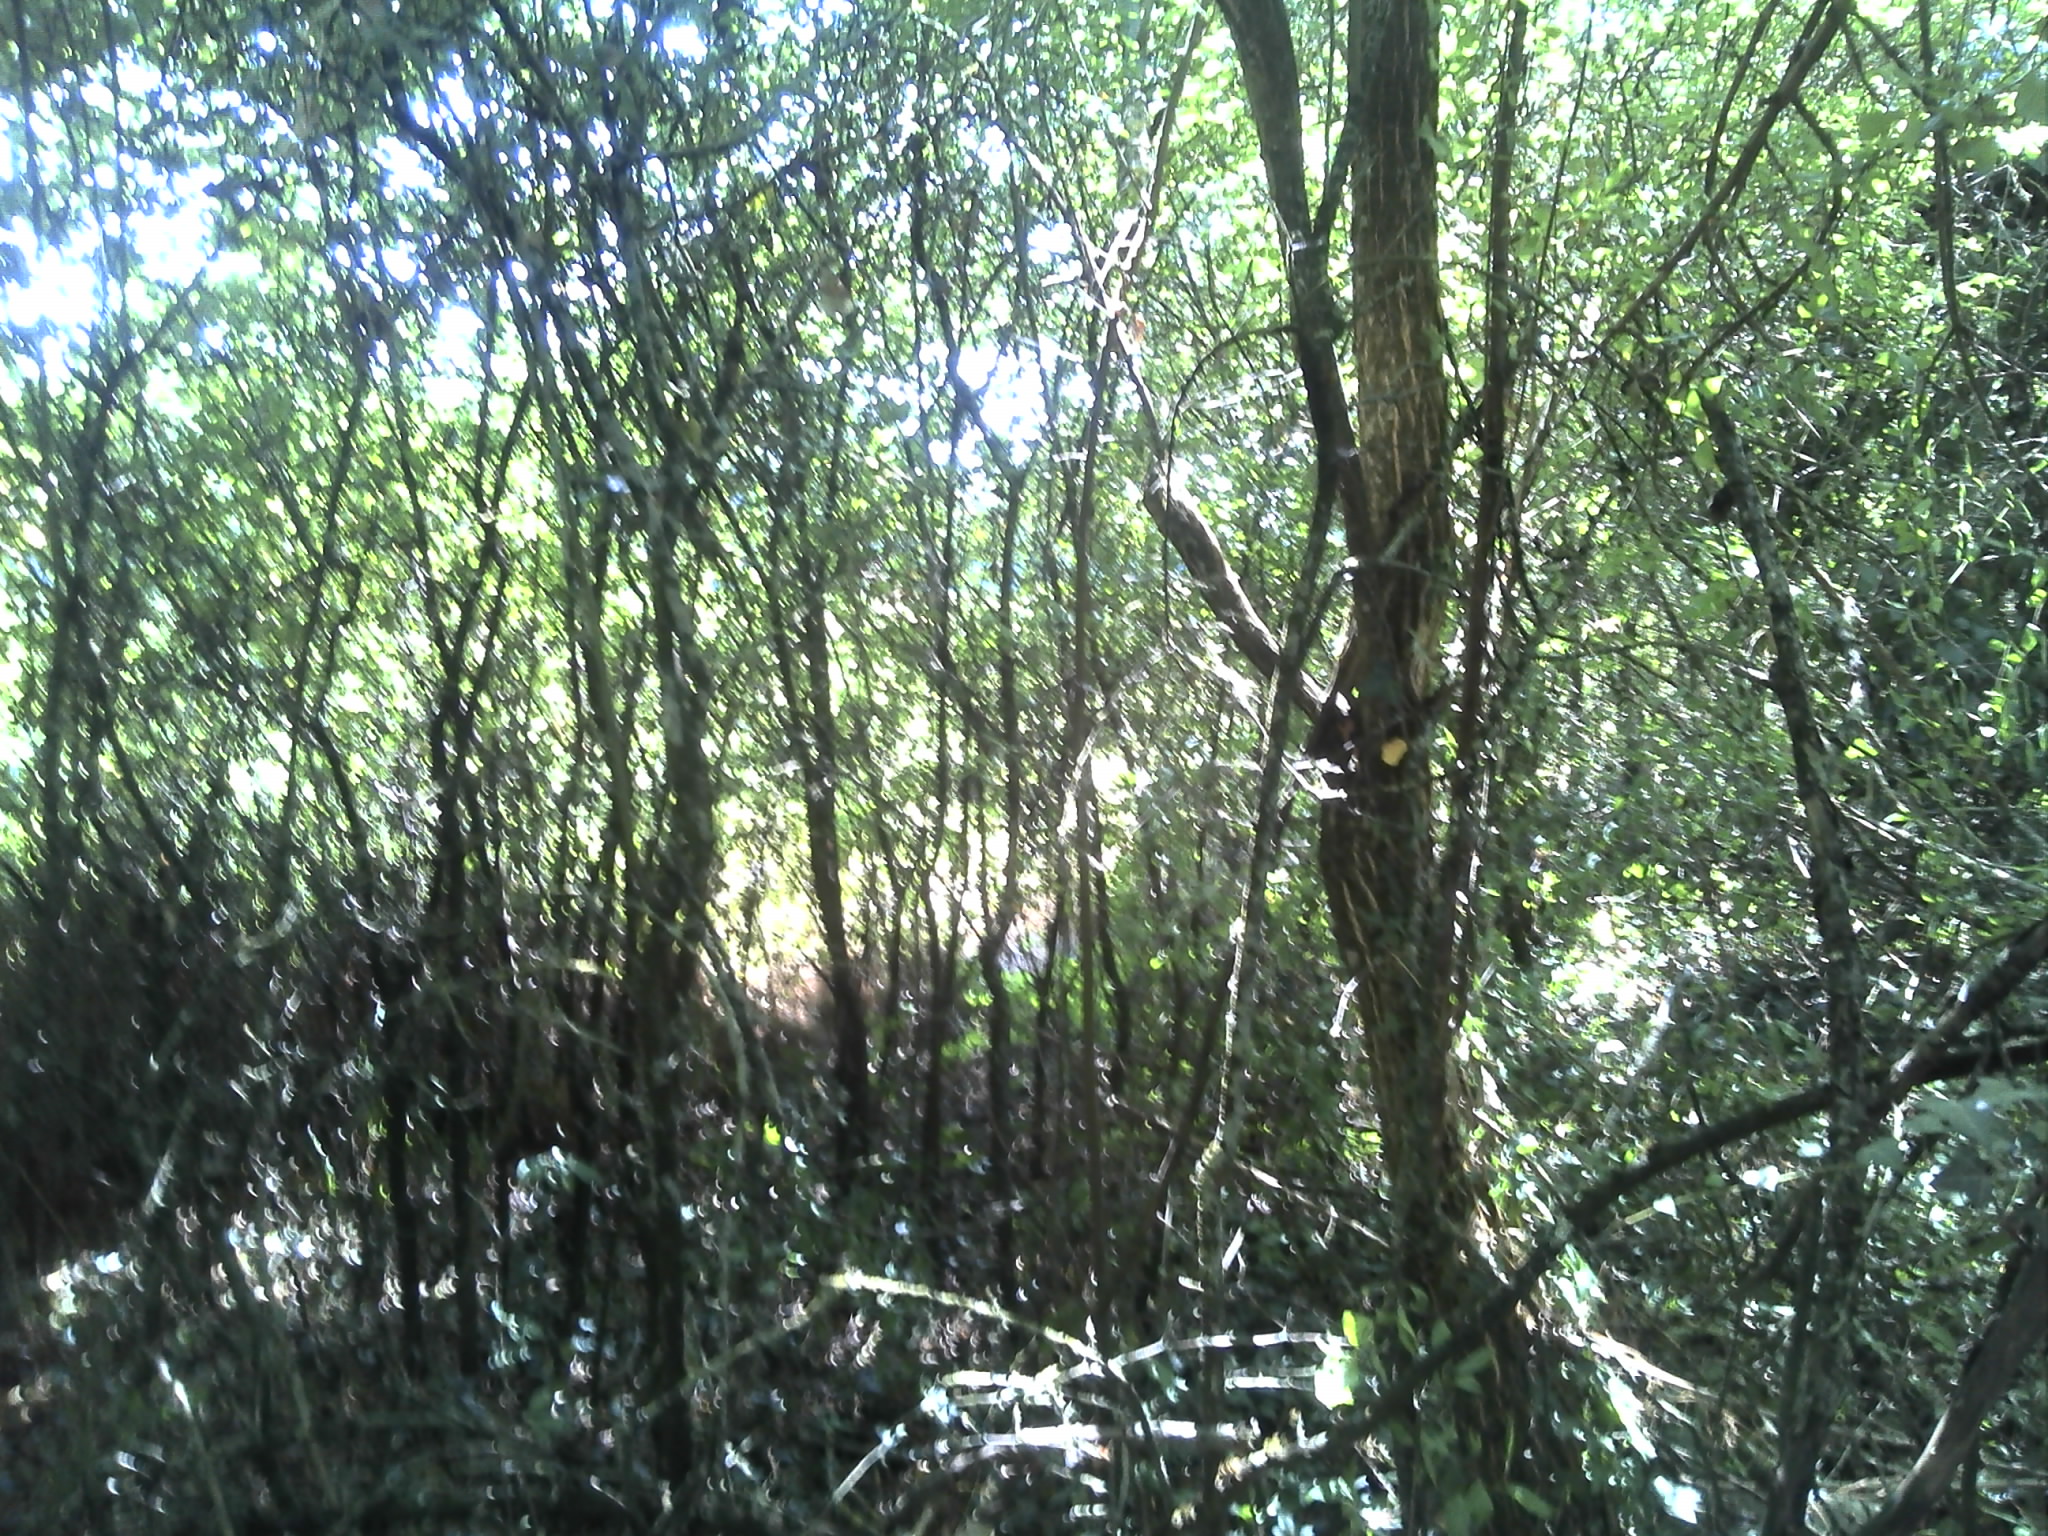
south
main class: Woodland
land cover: Broadleaved woodland
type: mesophytic deciduous forest
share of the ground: > 75 %
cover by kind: broadleaved forest trees 90 %, shrubs 10 %
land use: Agriculture (excluding fallow land and kitchen gardens)
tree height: > 5 m
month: August
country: FR
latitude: 46.8317
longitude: 1.5590
